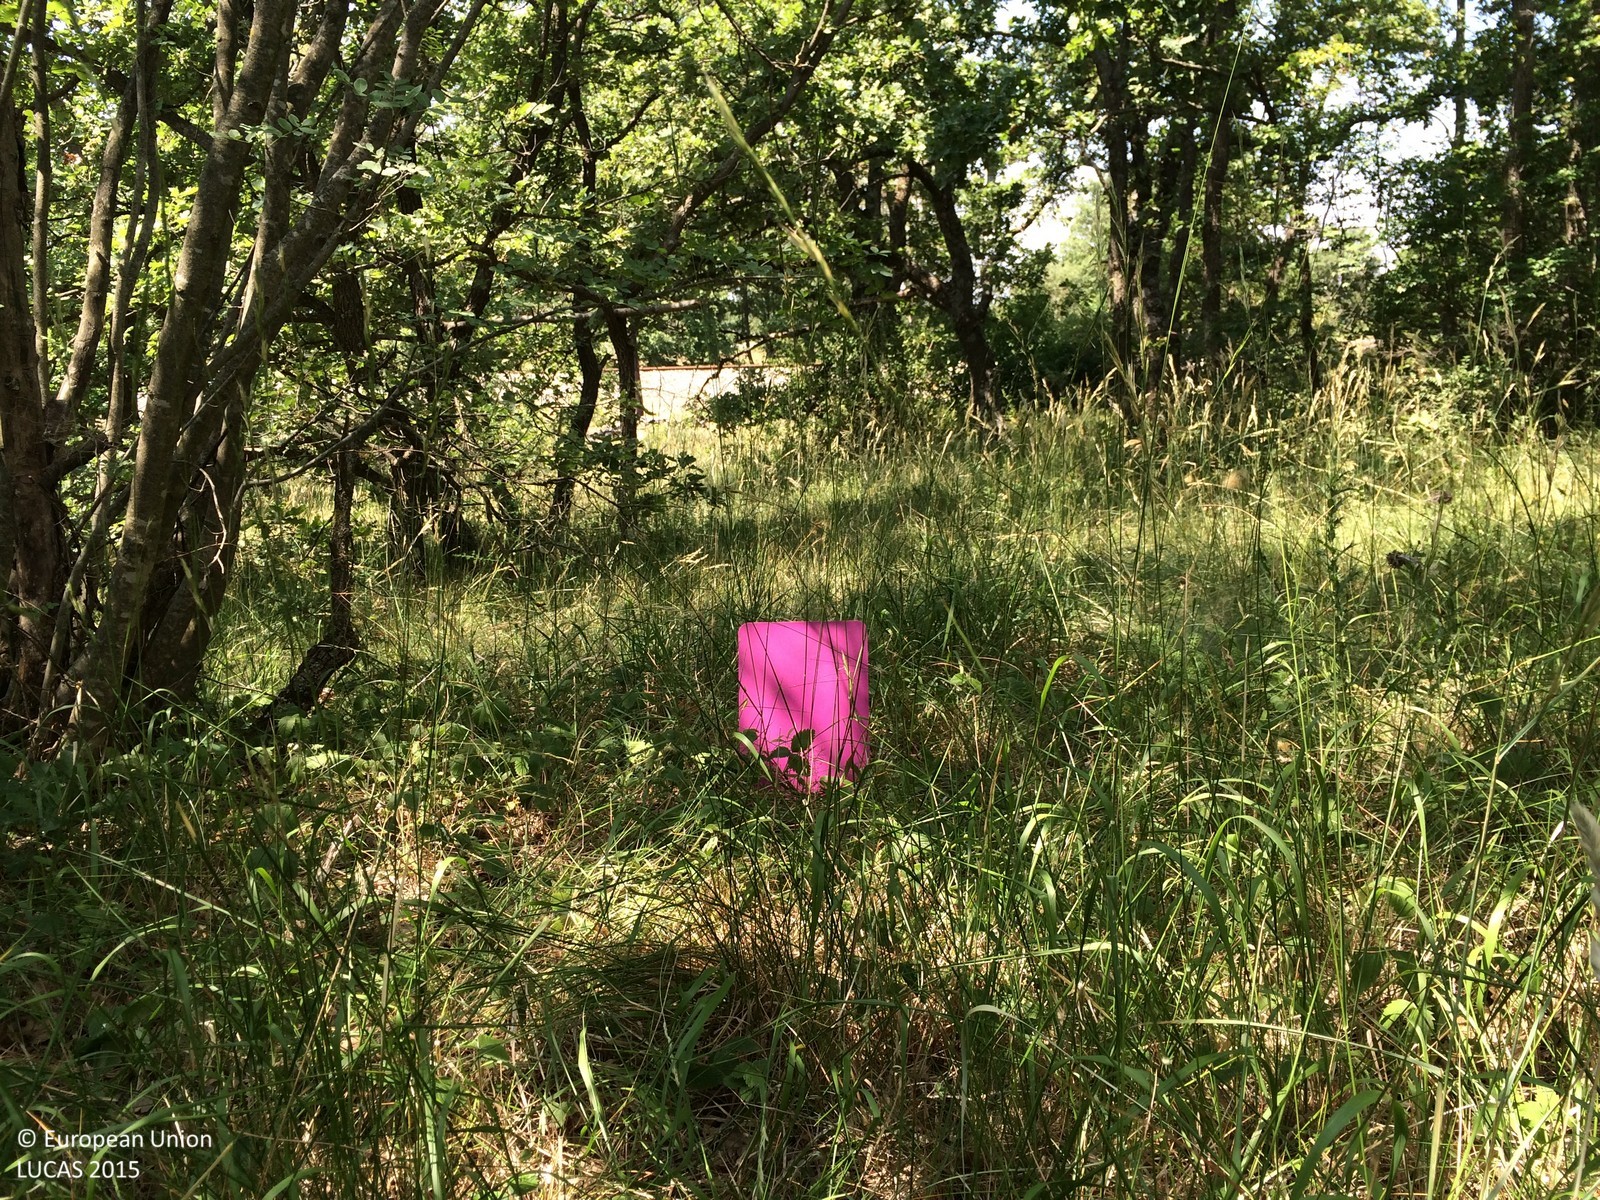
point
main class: Grassland
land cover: Grassland with sparse tree/shrub cover
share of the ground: 50 - 75 %
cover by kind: herbaceous plants 90 %, broadleaved forest trees 5 %, shrubs 5 %
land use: Semi-natural and natural areas not in use
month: June
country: HR
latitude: 45.0367
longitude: 13.8661
